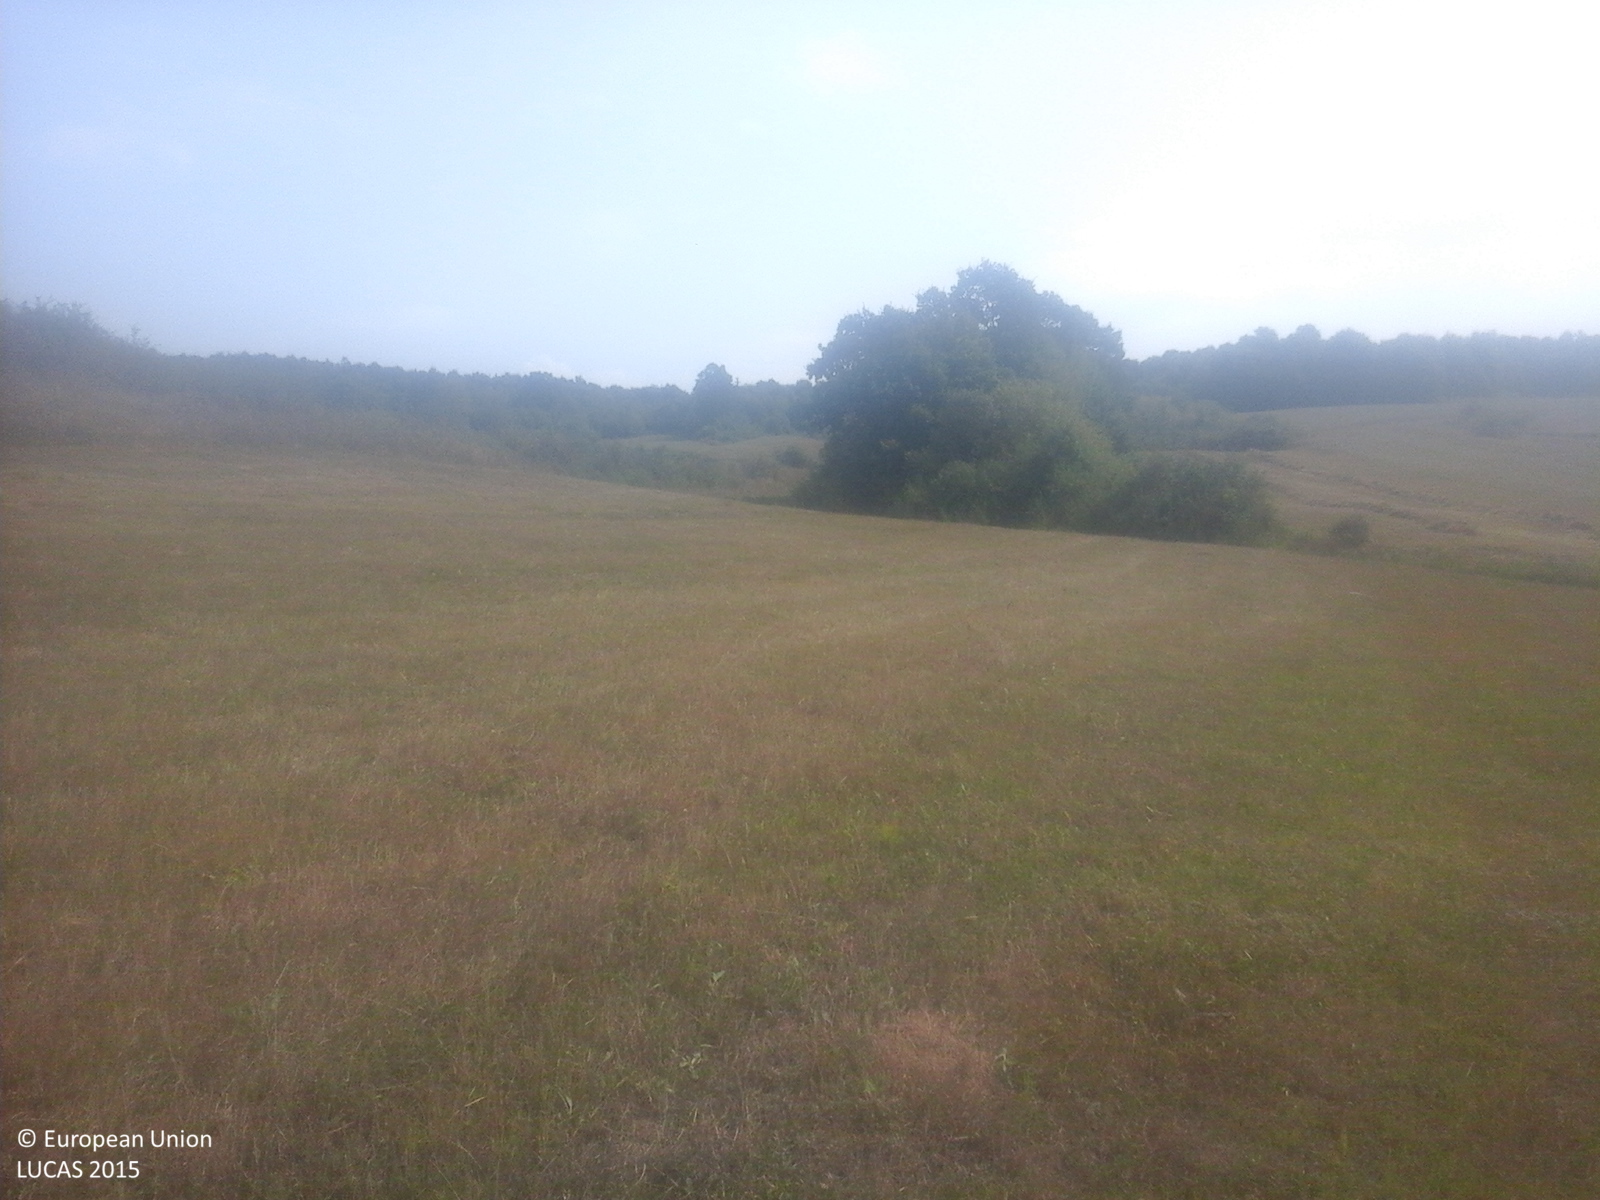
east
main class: Grassland
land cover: Grassland without tree/shrub cover
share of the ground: > 75 %
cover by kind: herbaceous plants 100 %
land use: Agriculture (excluding fallow land and kitchen gardens)
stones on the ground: < 10 %
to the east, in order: Grassland without tree/shrub cover; Shrubland with sparse tree cover; Grassland without tree/shrub cover; Tracks; Grassland without tree/shrub cover
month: September
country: RO
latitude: 47.4765
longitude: 23.8132
